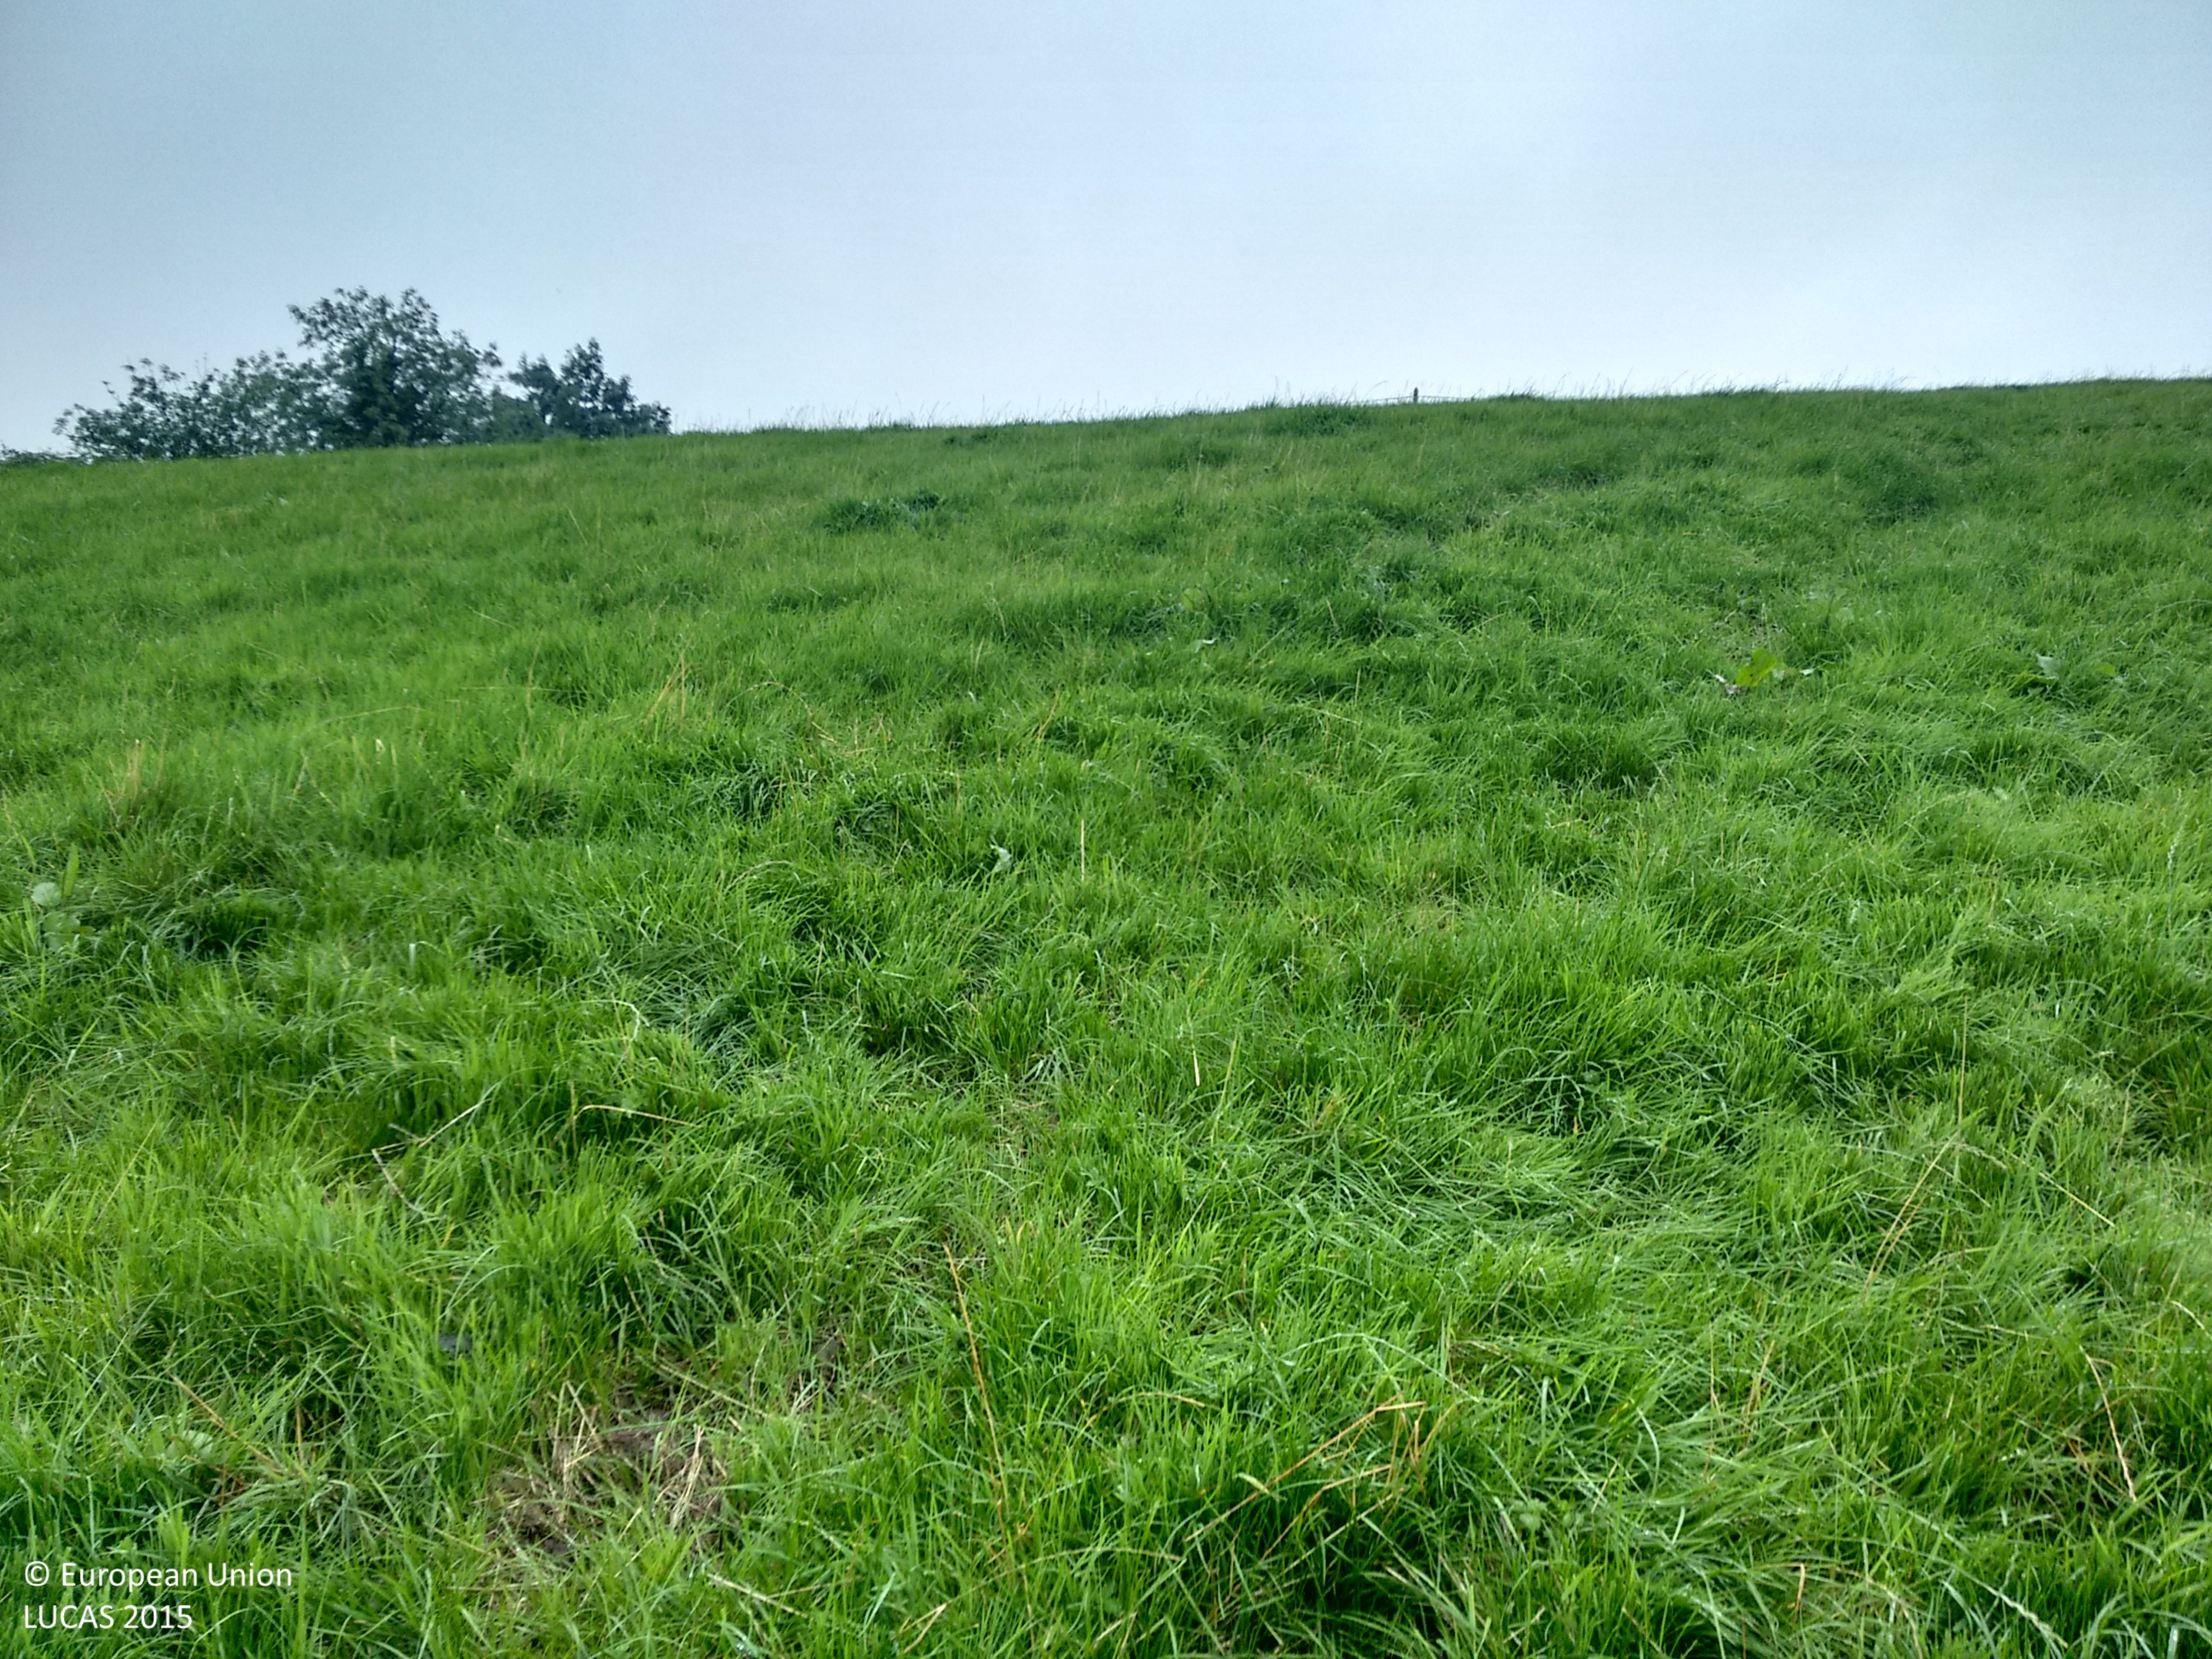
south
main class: Grassland
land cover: Grassland without tree/shrub cover
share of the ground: > 75 %
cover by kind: herbaceous plants 100 %
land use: Agriculture (excluding fallow land and kitchen gardens)
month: August
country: IE
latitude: 53.8575
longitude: -7.1592
